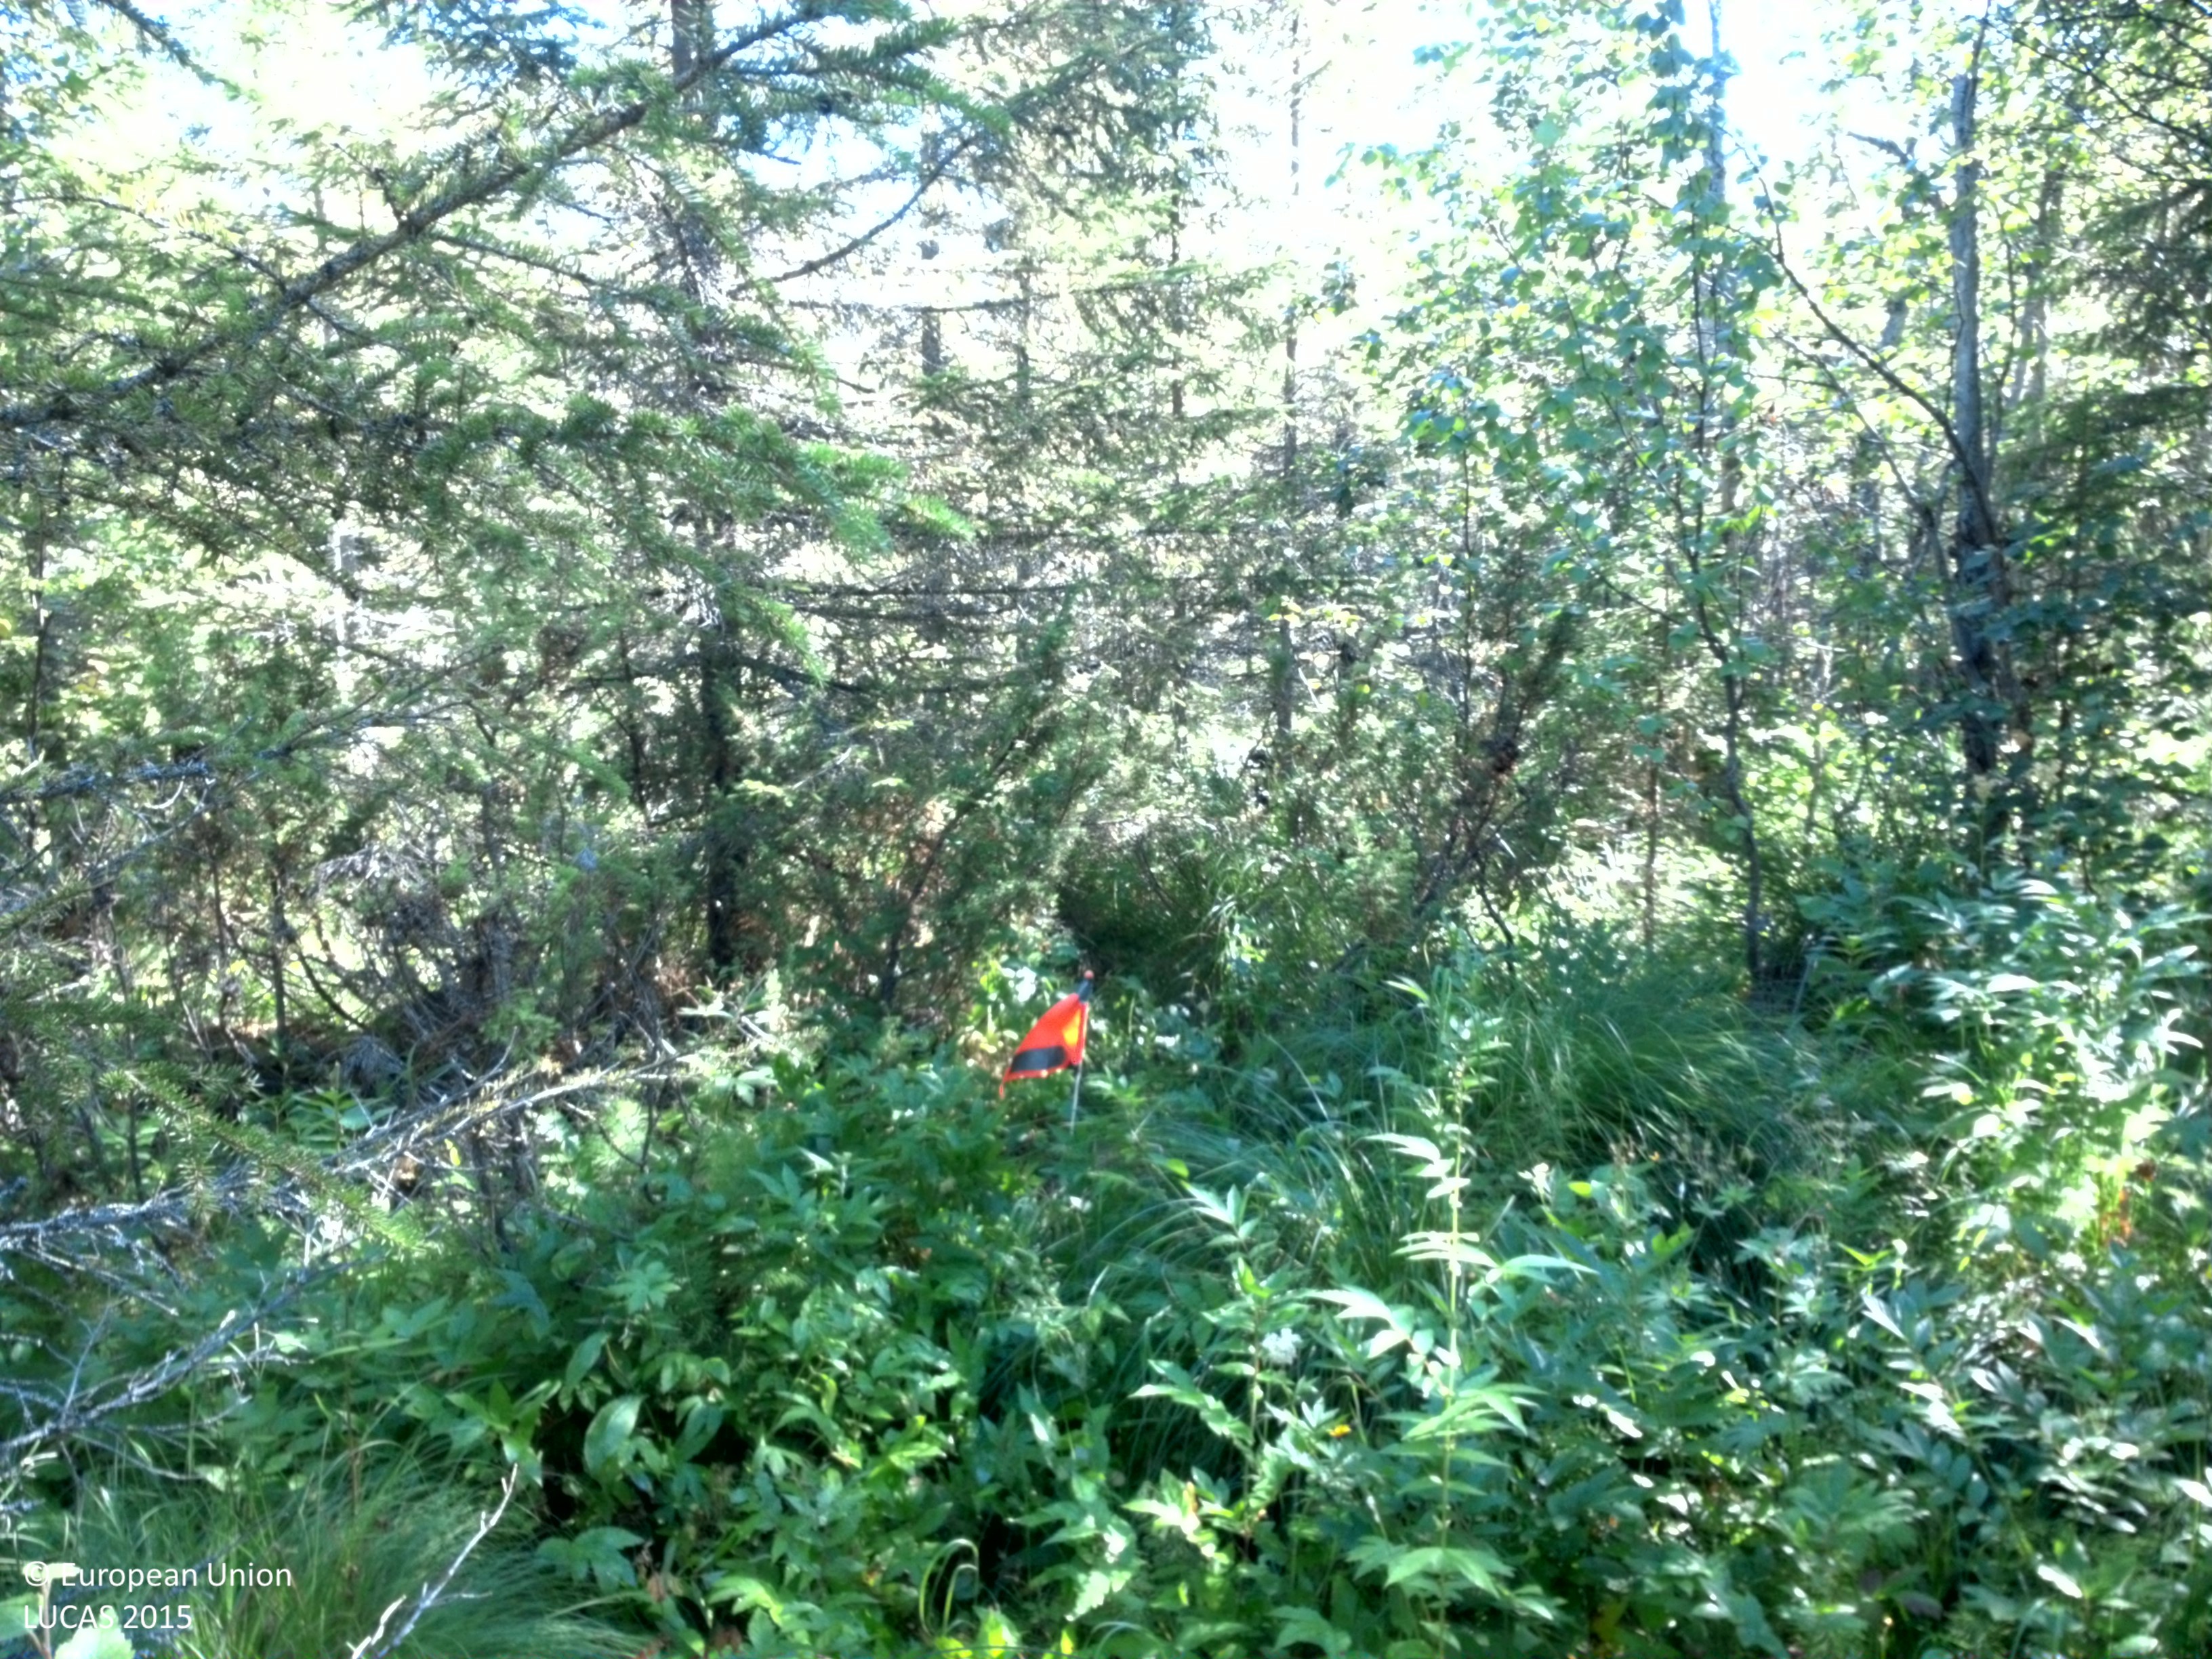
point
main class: Woodland
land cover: Spruce dominated mixed woodland
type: boreal forest
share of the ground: 25 - 50 %
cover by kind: herbaceous plants 50 %, coniferous forest trees 25 %, broadleaved forest trees 20 %, shrubs 5 %
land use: Forestry
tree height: > 5 m
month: August
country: SE
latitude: 64.7331
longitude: 16.1194
